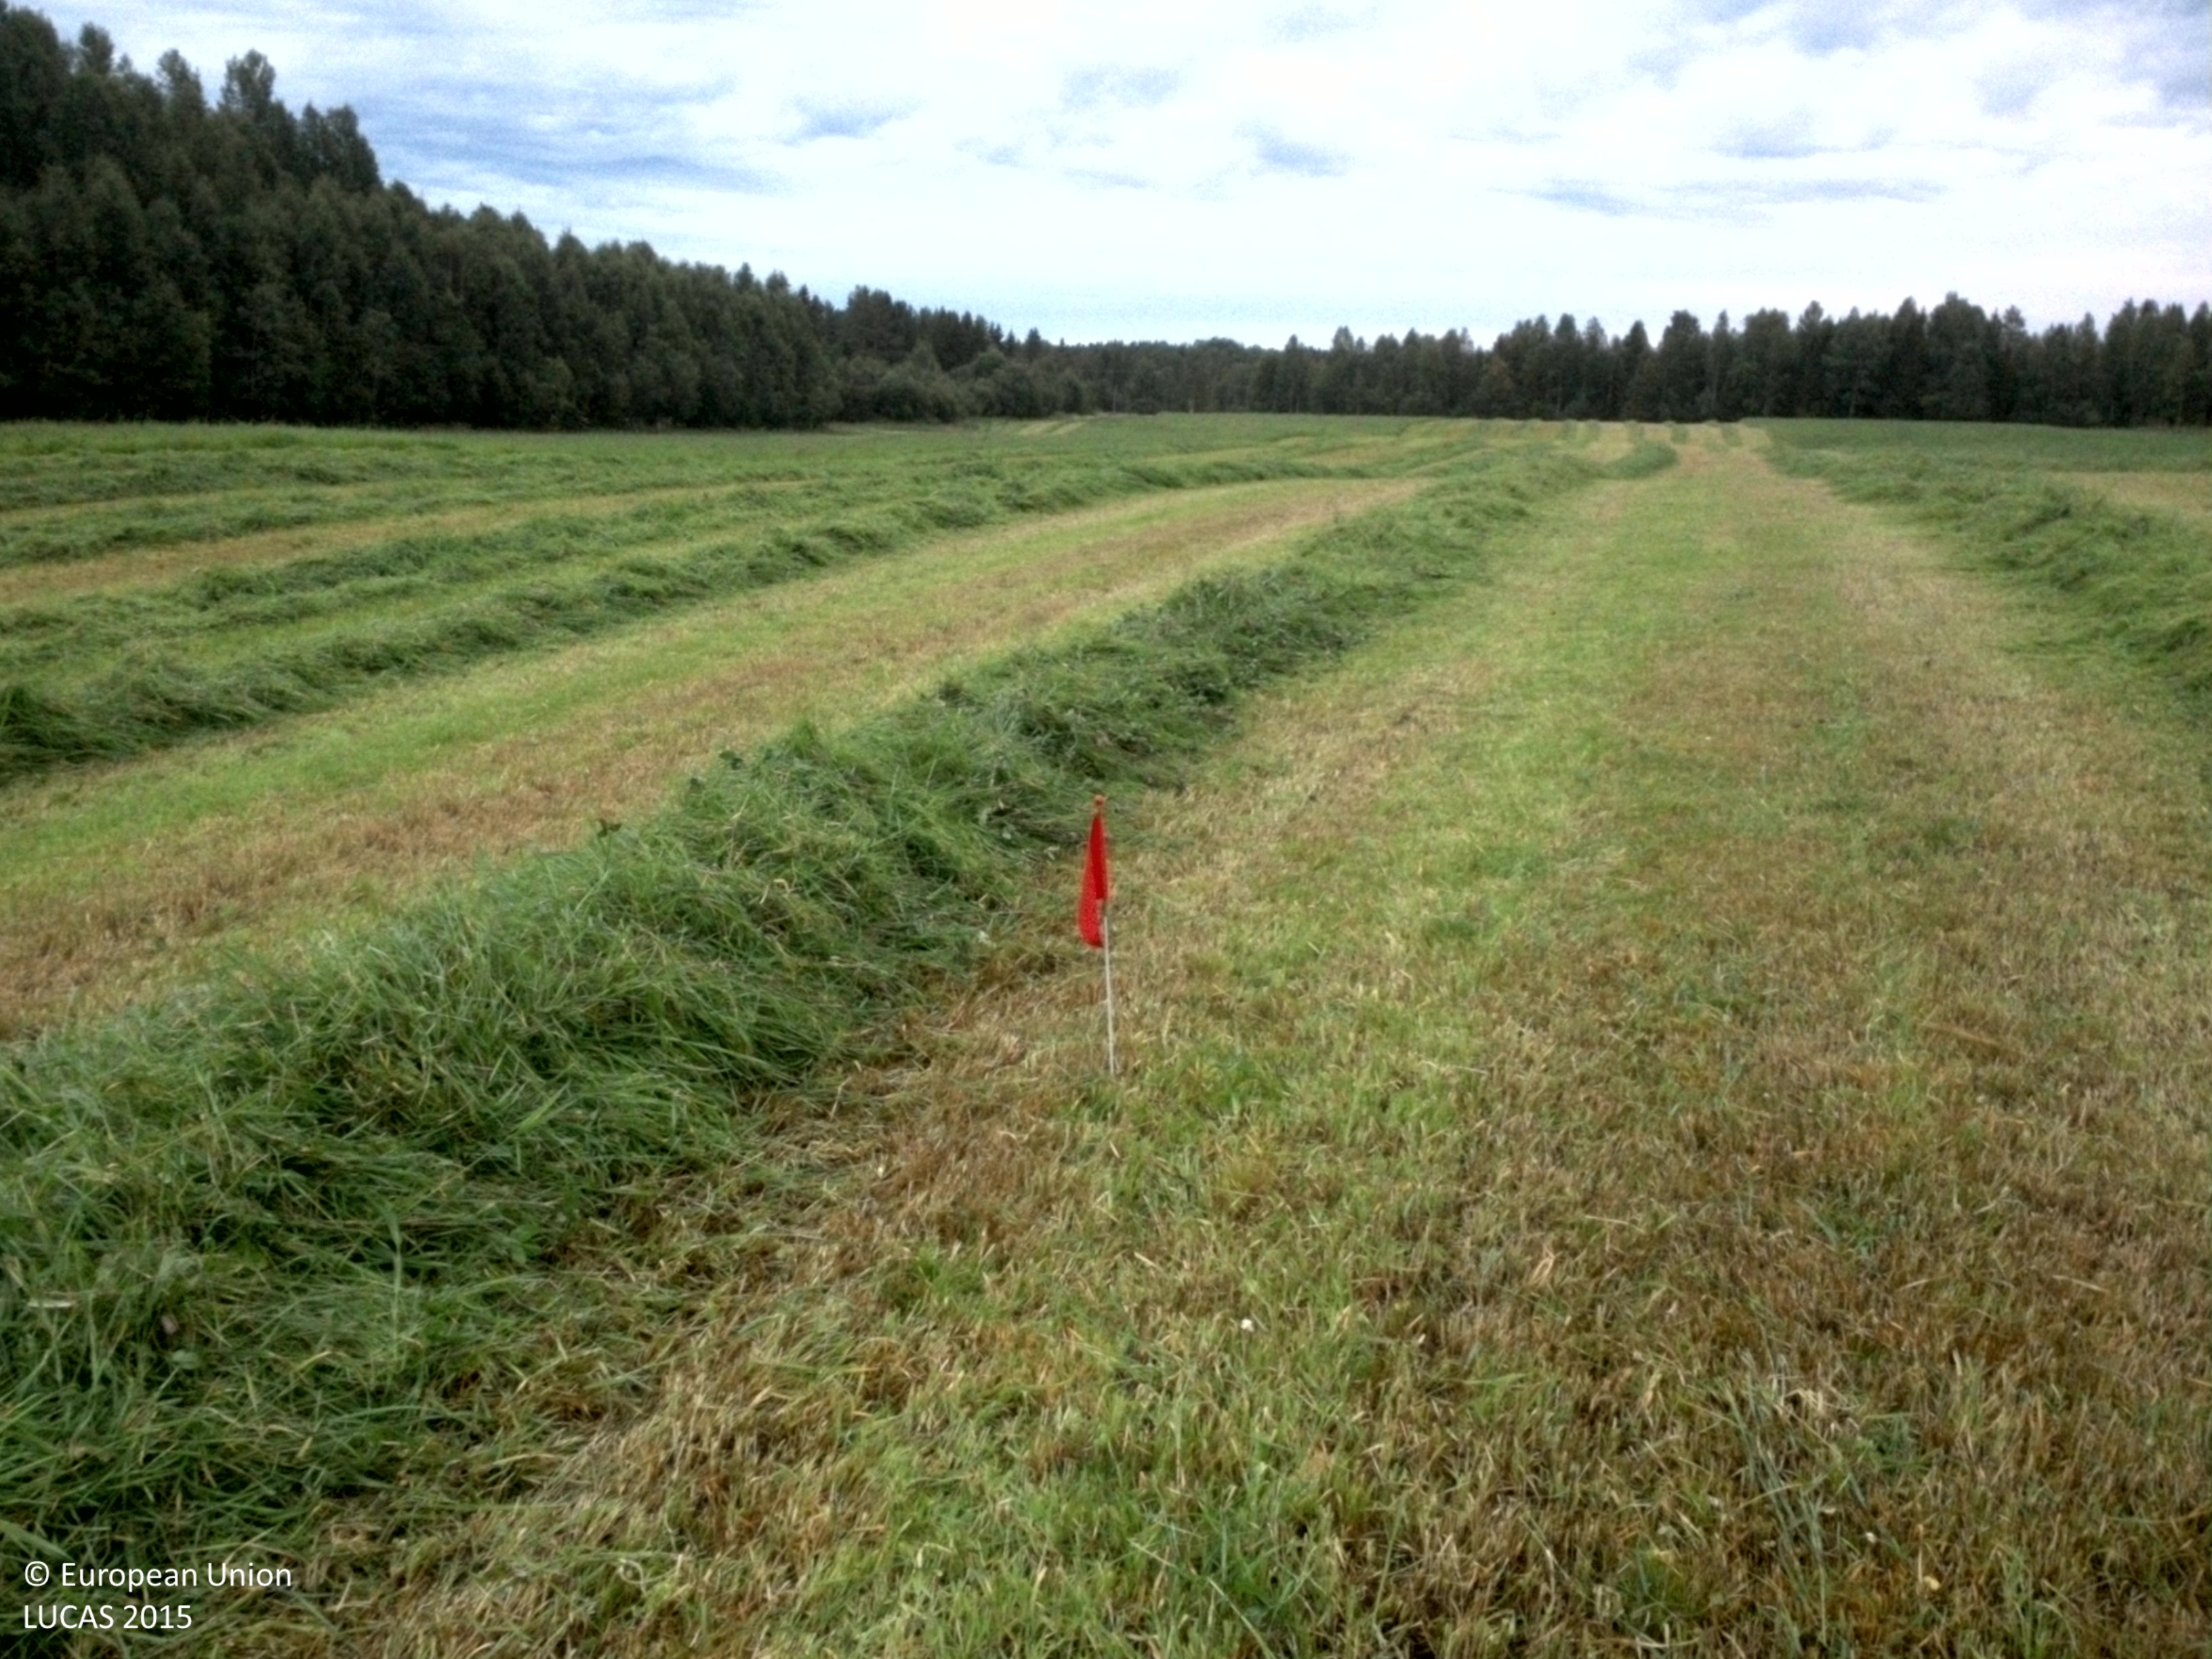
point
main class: Cropland
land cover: Other leguminous and mixtures for fodder
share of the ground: > 75 %
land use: Agriculture (excluding fallow land and kitchen gardens)
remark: Harvested field
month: August
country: SE
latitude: 64.4800
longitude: 20.6086
